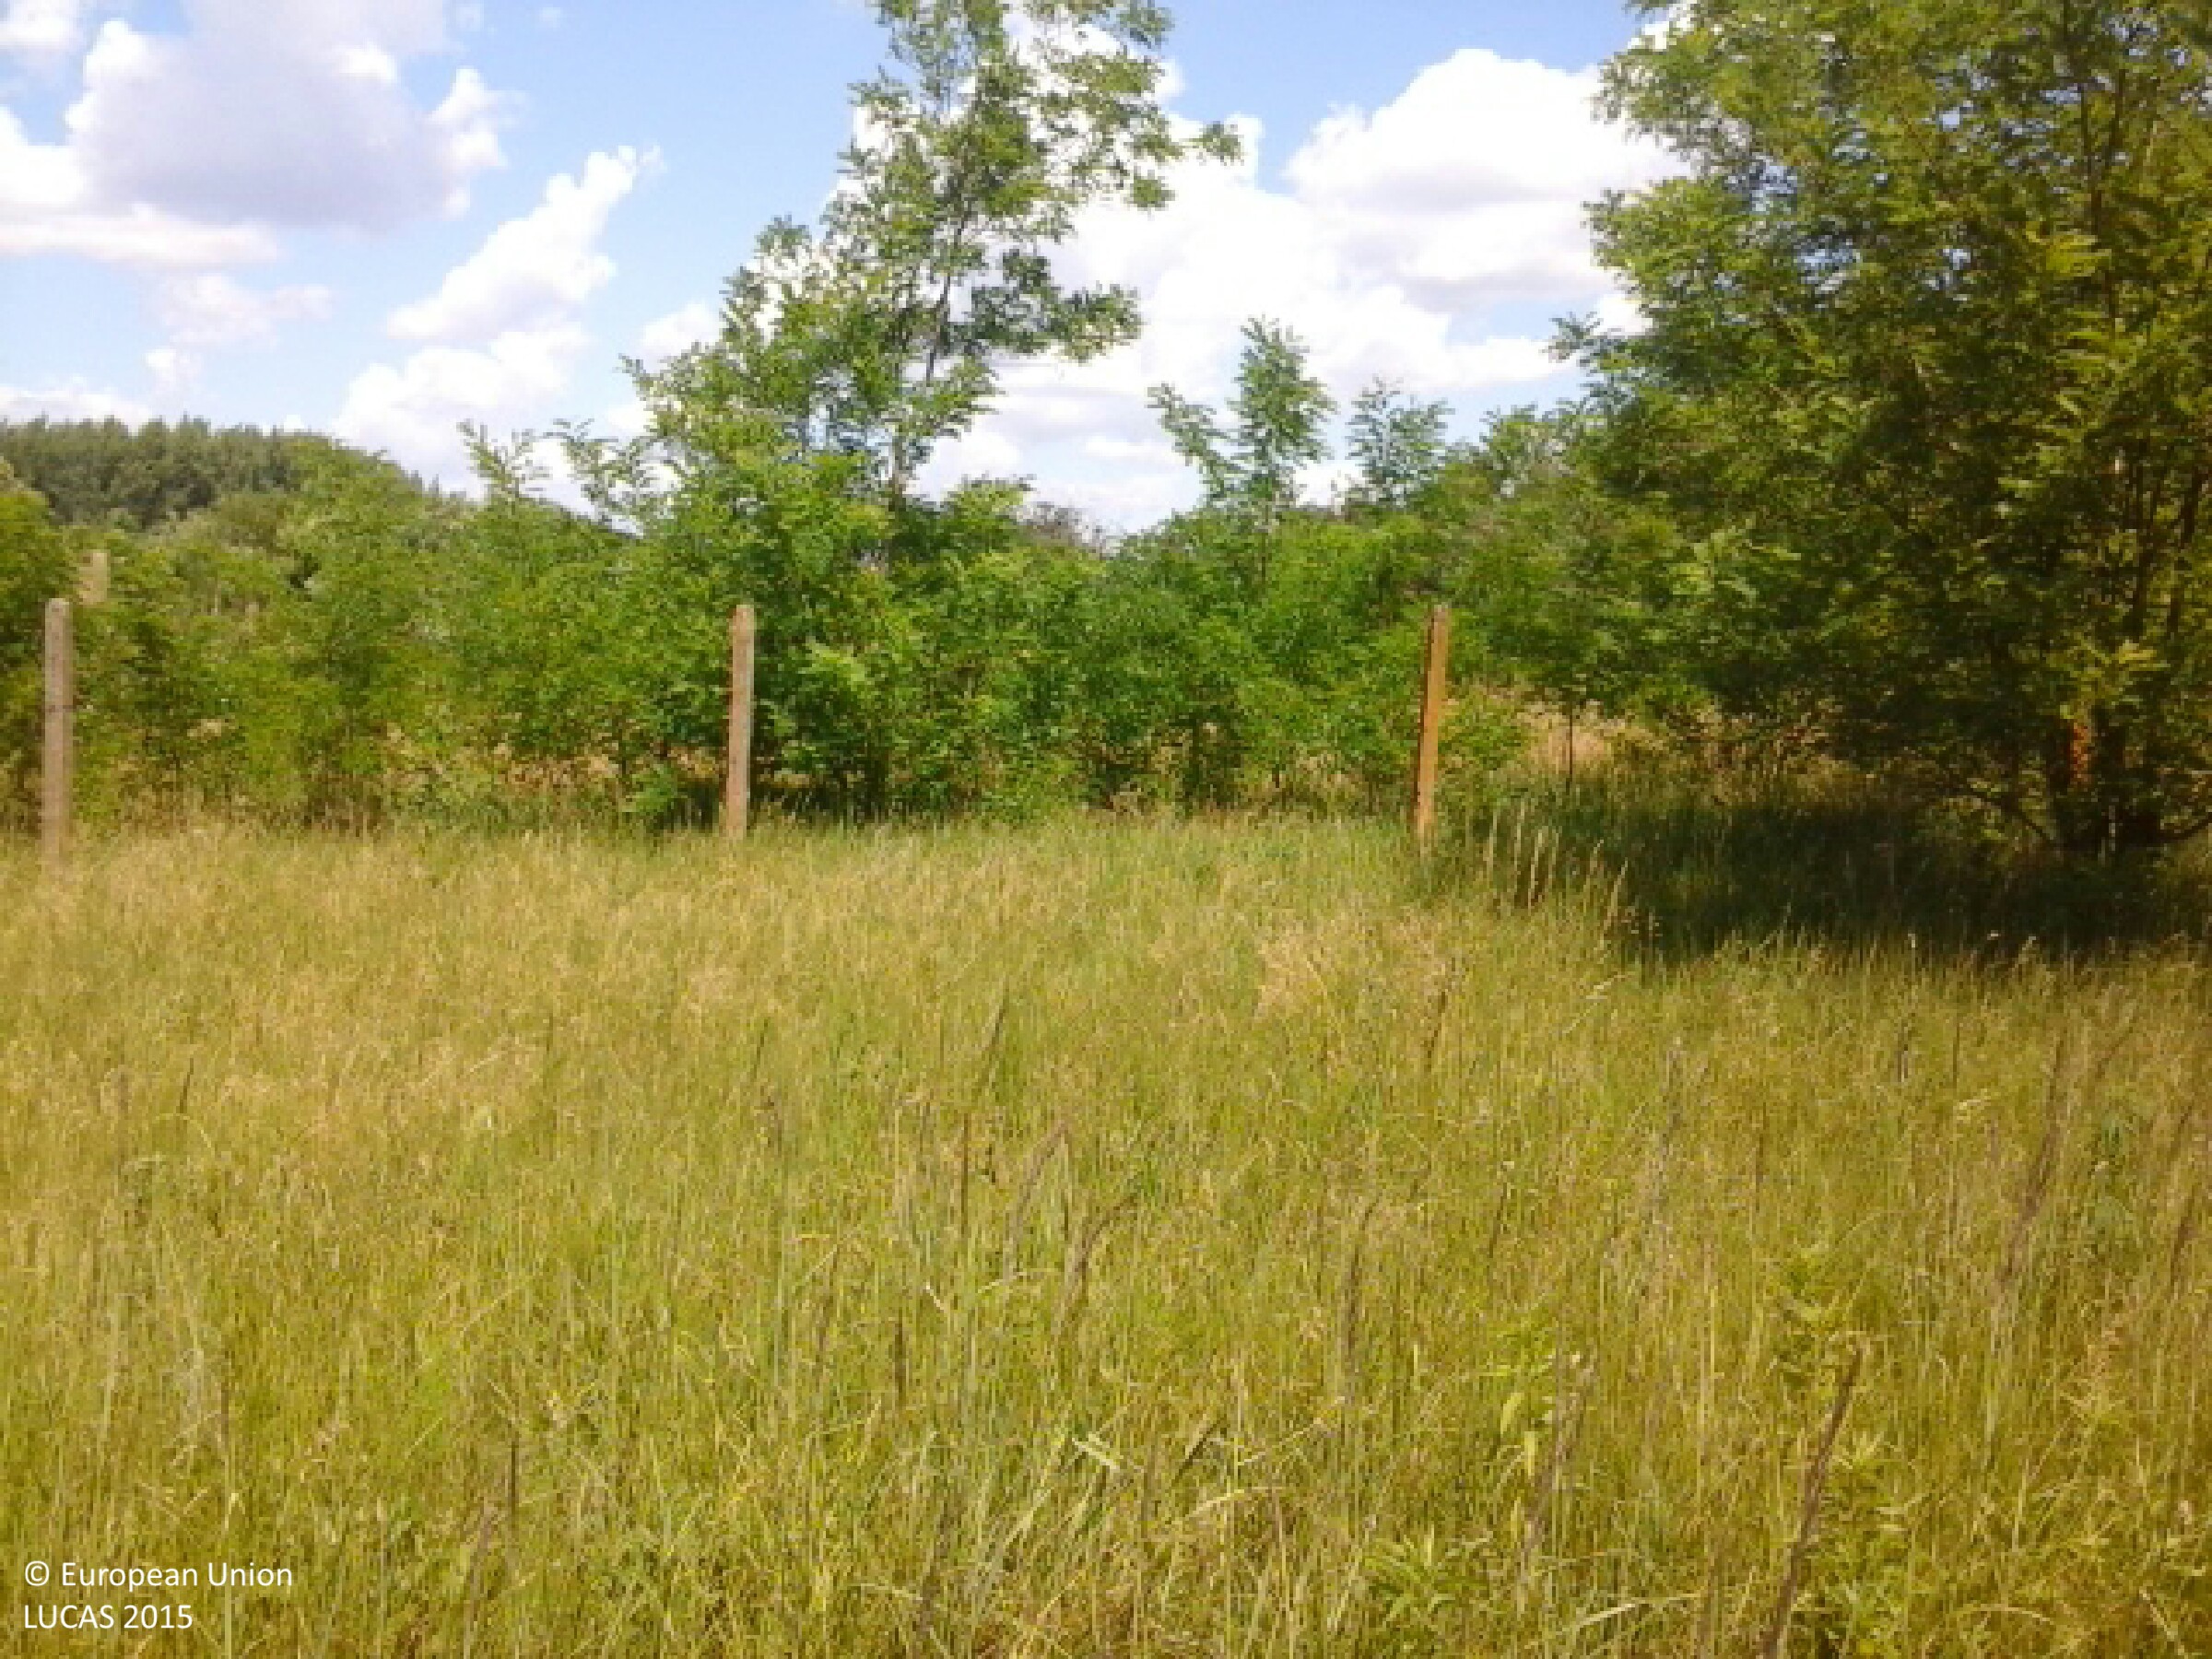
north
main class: Grassland
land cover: Grassland without tree/shrub cover
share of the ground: > 75 %
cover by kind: herbaceous plants 100 %
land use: Semi-natural and natural areas not in use
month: June
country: HU
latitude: 48.0342
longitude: 21.7025
